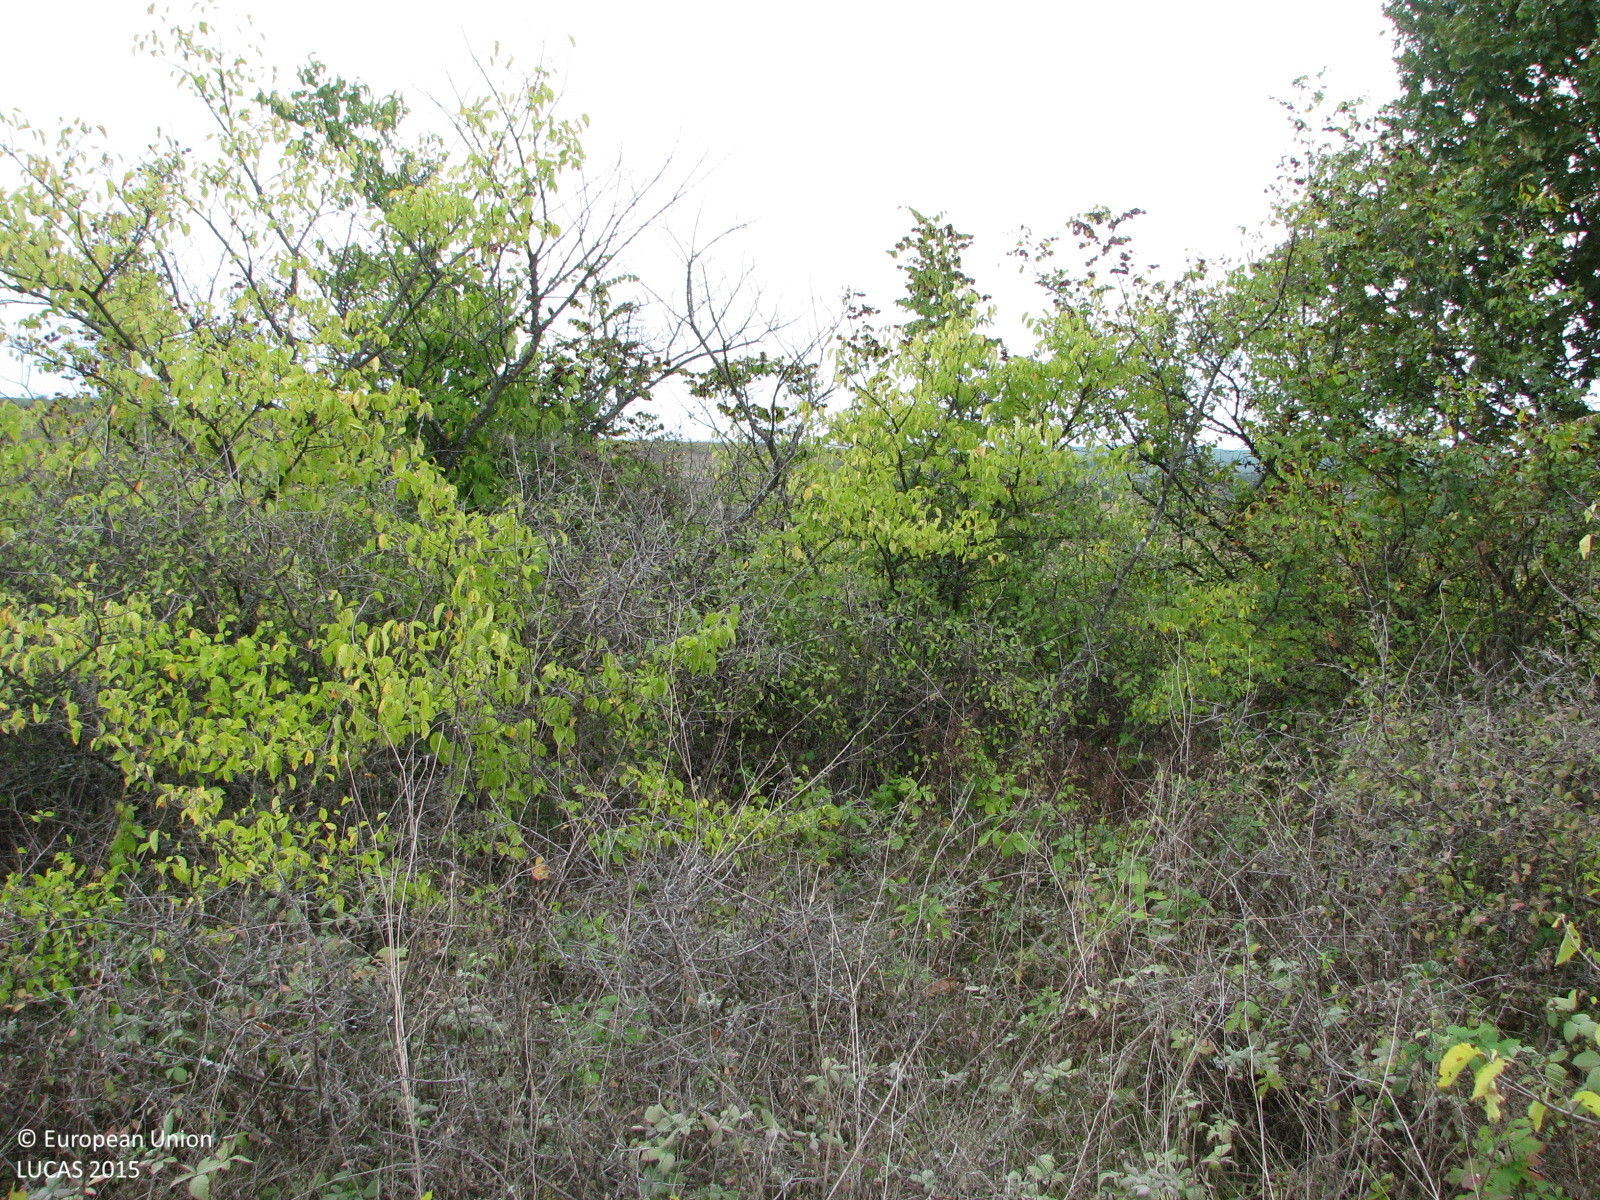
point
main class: Shrubland
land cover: Shrubland with sparse tree cover
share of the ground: 50 - 75 %
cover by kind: shrubs 60 %, herbaceous plants 35 %, broadleaved forest trees 5 %
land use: Semi-natural and natural areas not in use
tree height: < 5 m
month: October
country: BG
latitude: 42.1371
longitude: 26.3819
